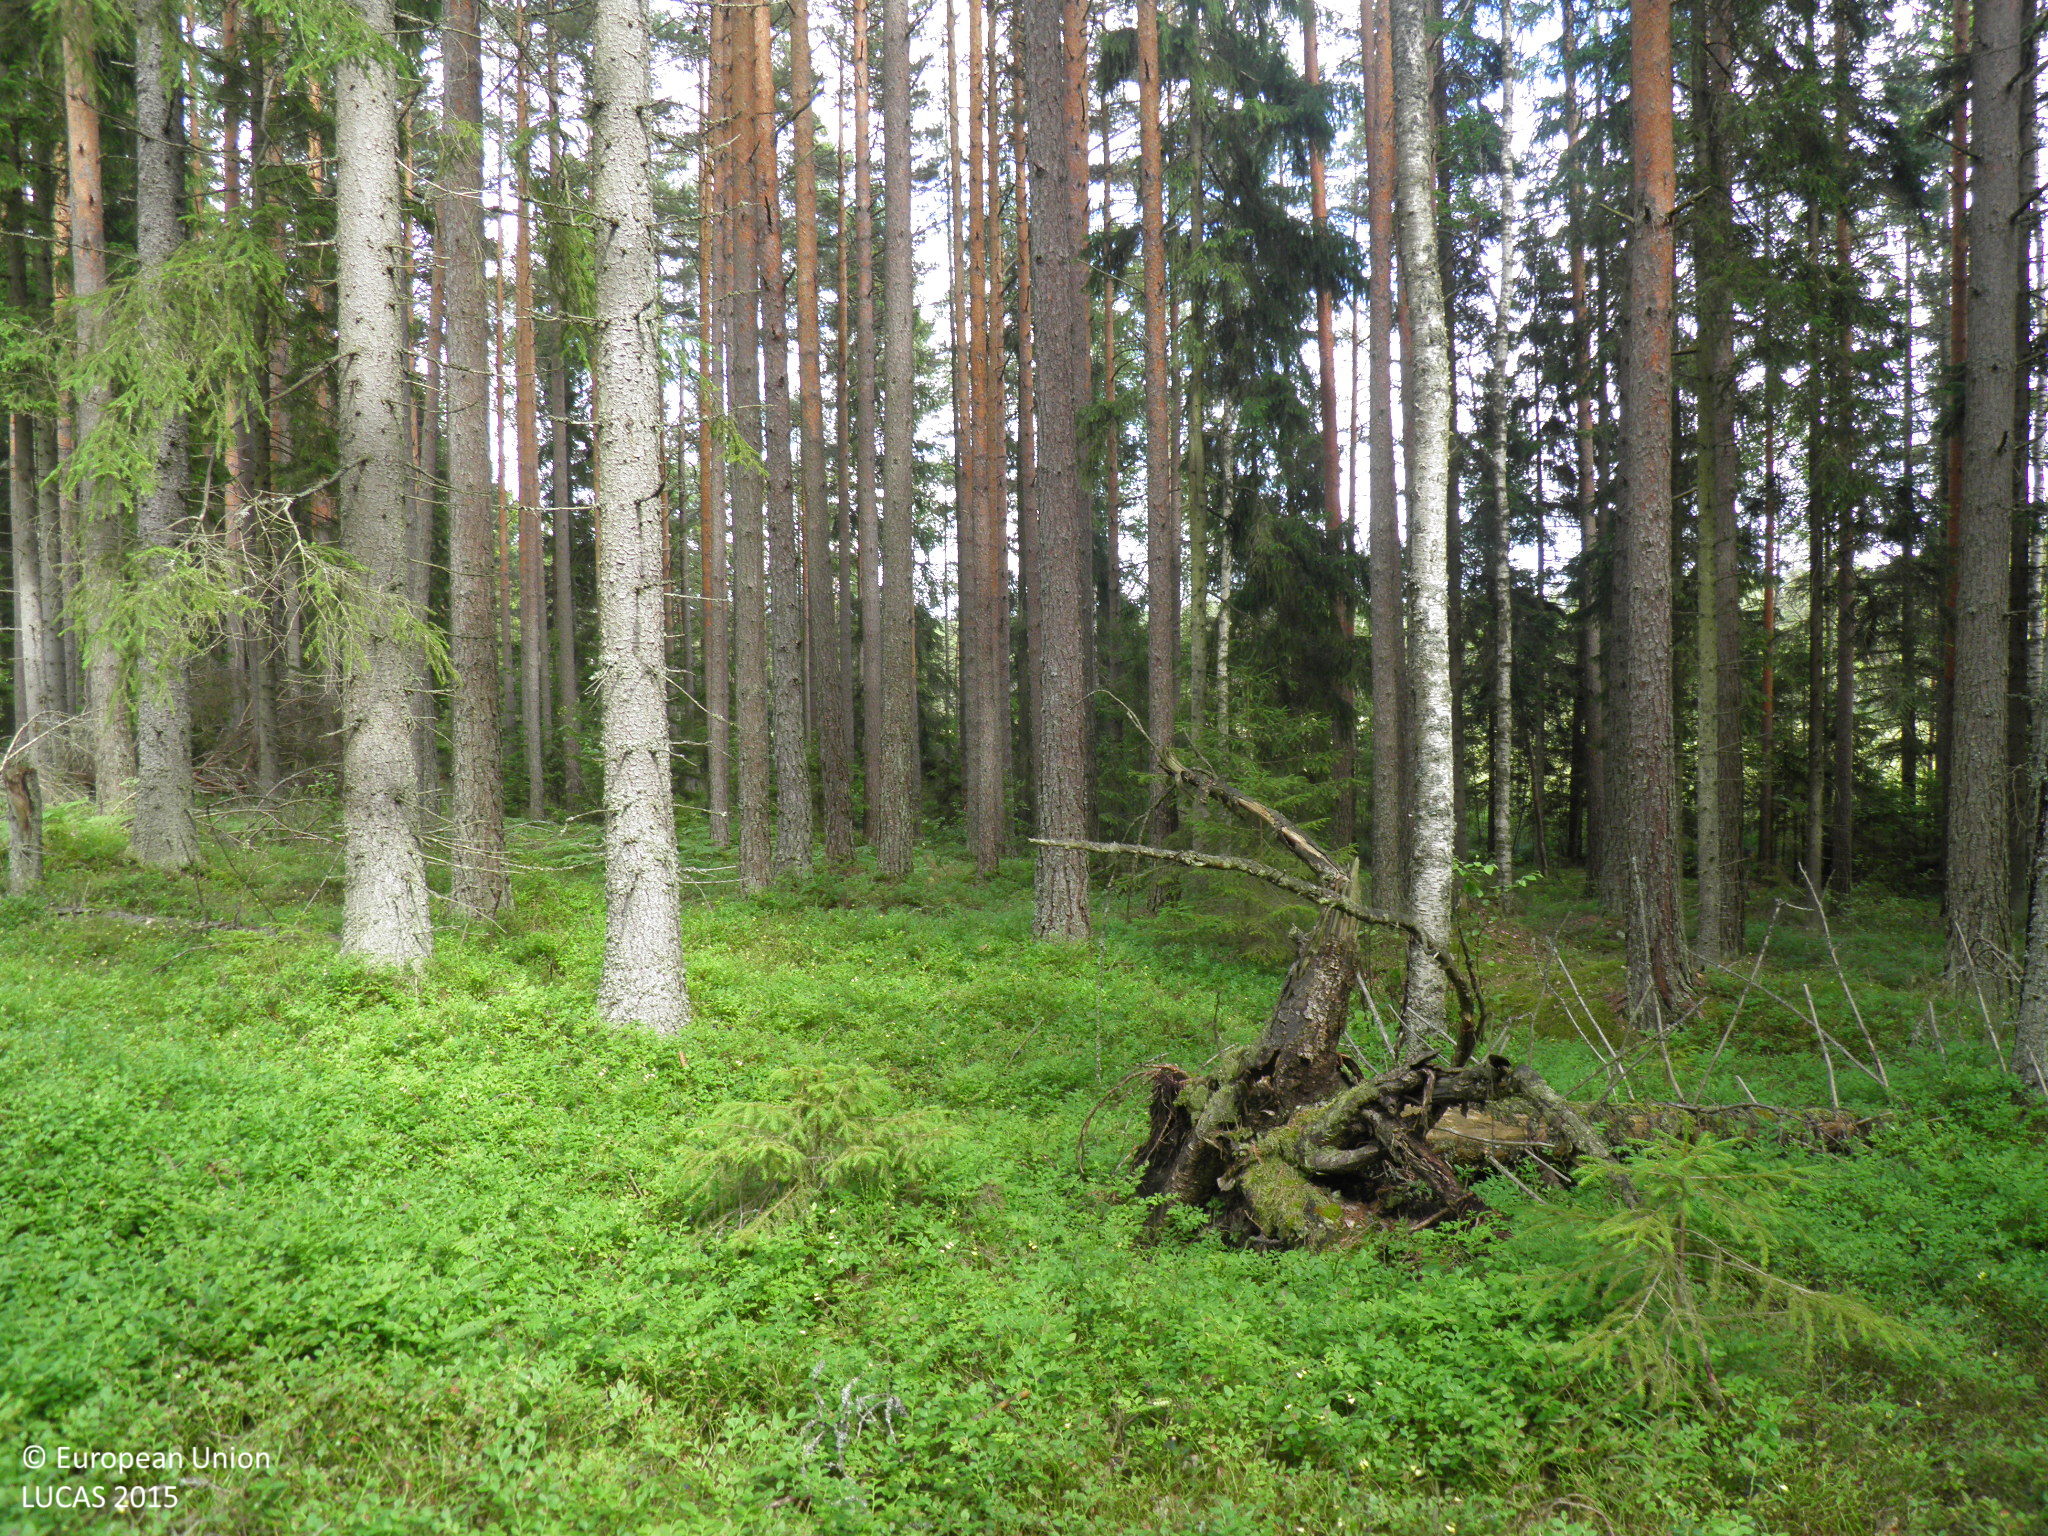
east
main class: Woodland
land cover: Spruce dominated coniferous woodland
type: boreal forest
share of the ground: 50 - 75 %
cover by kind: shrubs 50 %, coniferous forest trees 40 %, broadleaved forest trees 10 %
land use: Forestry
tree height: > 5 m
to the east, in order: Spruce dominated coniferous woodland; Pine dominated coniferous woodland; Peatbogs; Ditches and canals; Peatbogs; Pine dominated coniferous woodland
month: July
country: FI
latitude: 60.0583
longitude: 22.5208
